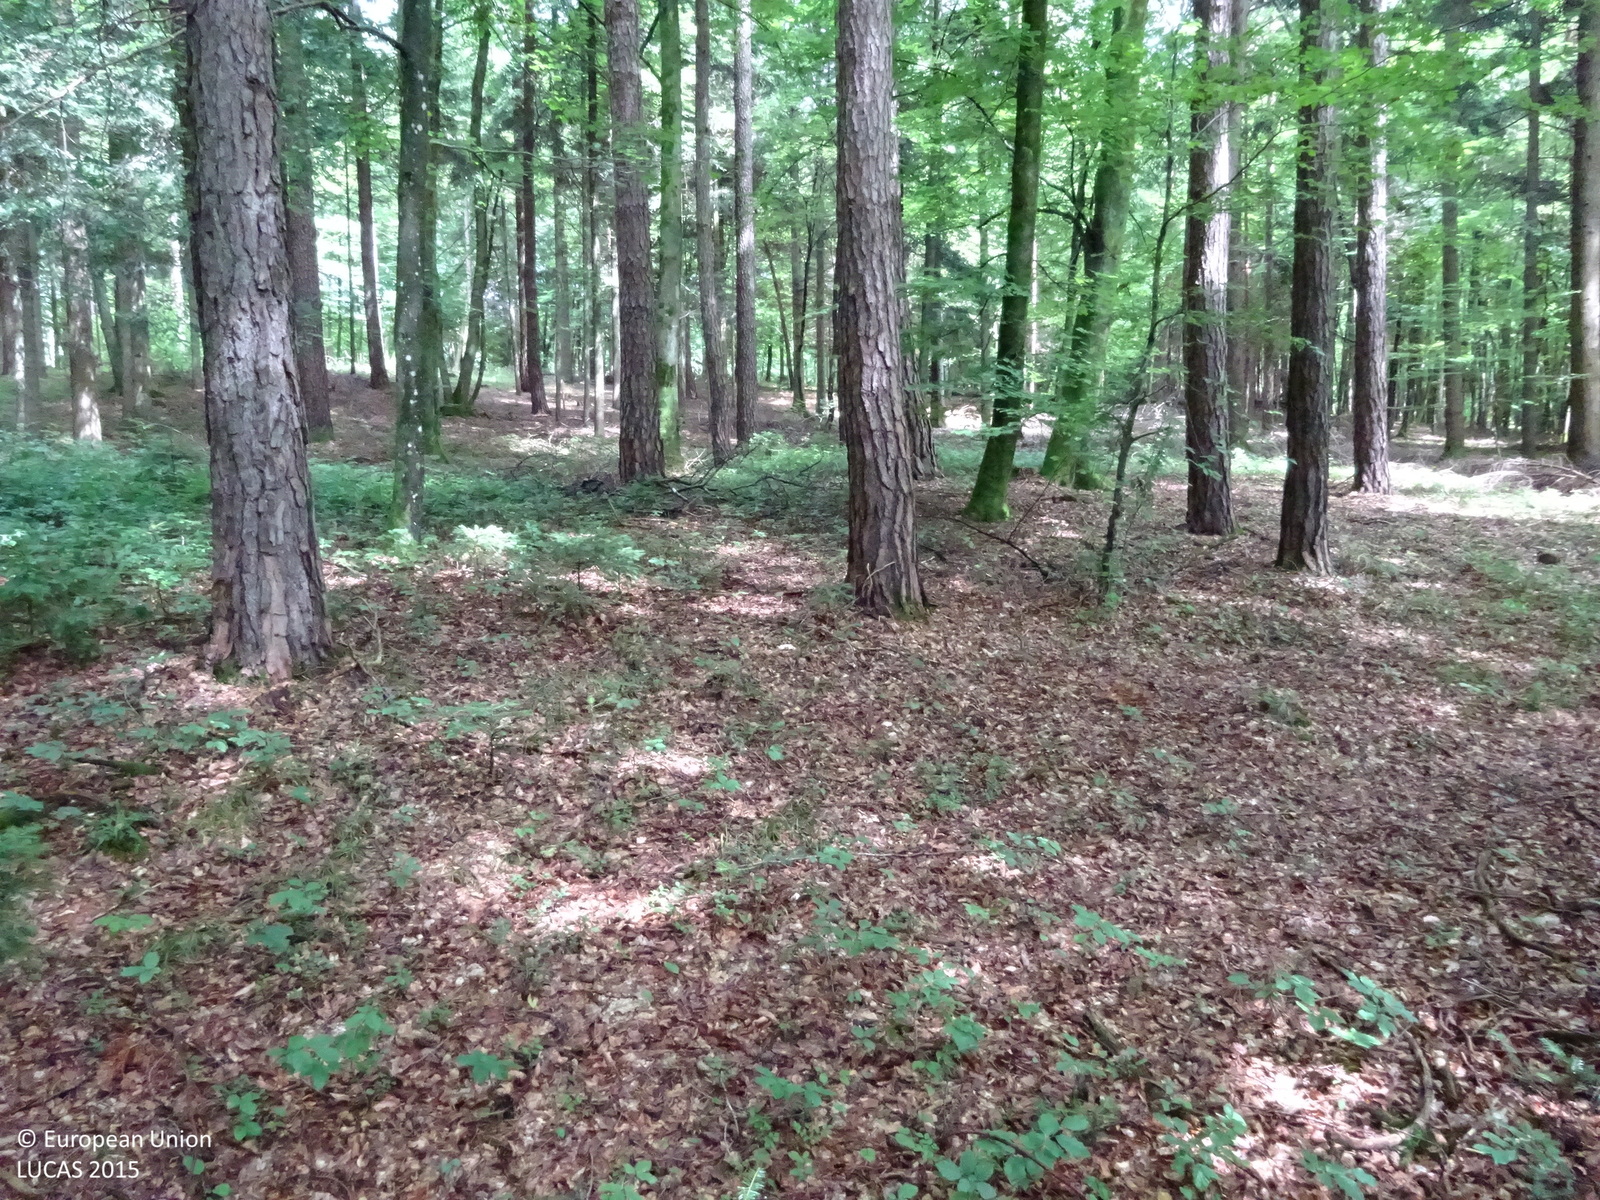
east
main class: Woodland
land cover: Pine dominated mixed woodland
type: mountainous beech forest
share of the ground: > 75 %
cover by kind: broadleaved forest trees 65 %, coniferous forest trees 25 %, herbaceous plants 10 %
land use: Forestry
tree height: > 5 m
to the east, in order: Pine dominated mixed woodland; Tracks; Pine dominated mixed woodland; Spruce dominated coniferous woodland; Tracks; Spruce dominated coniferous woodland; Spruce dominated mixed woodland
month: July
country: AT
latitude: 46.8509
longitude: 15.3106
